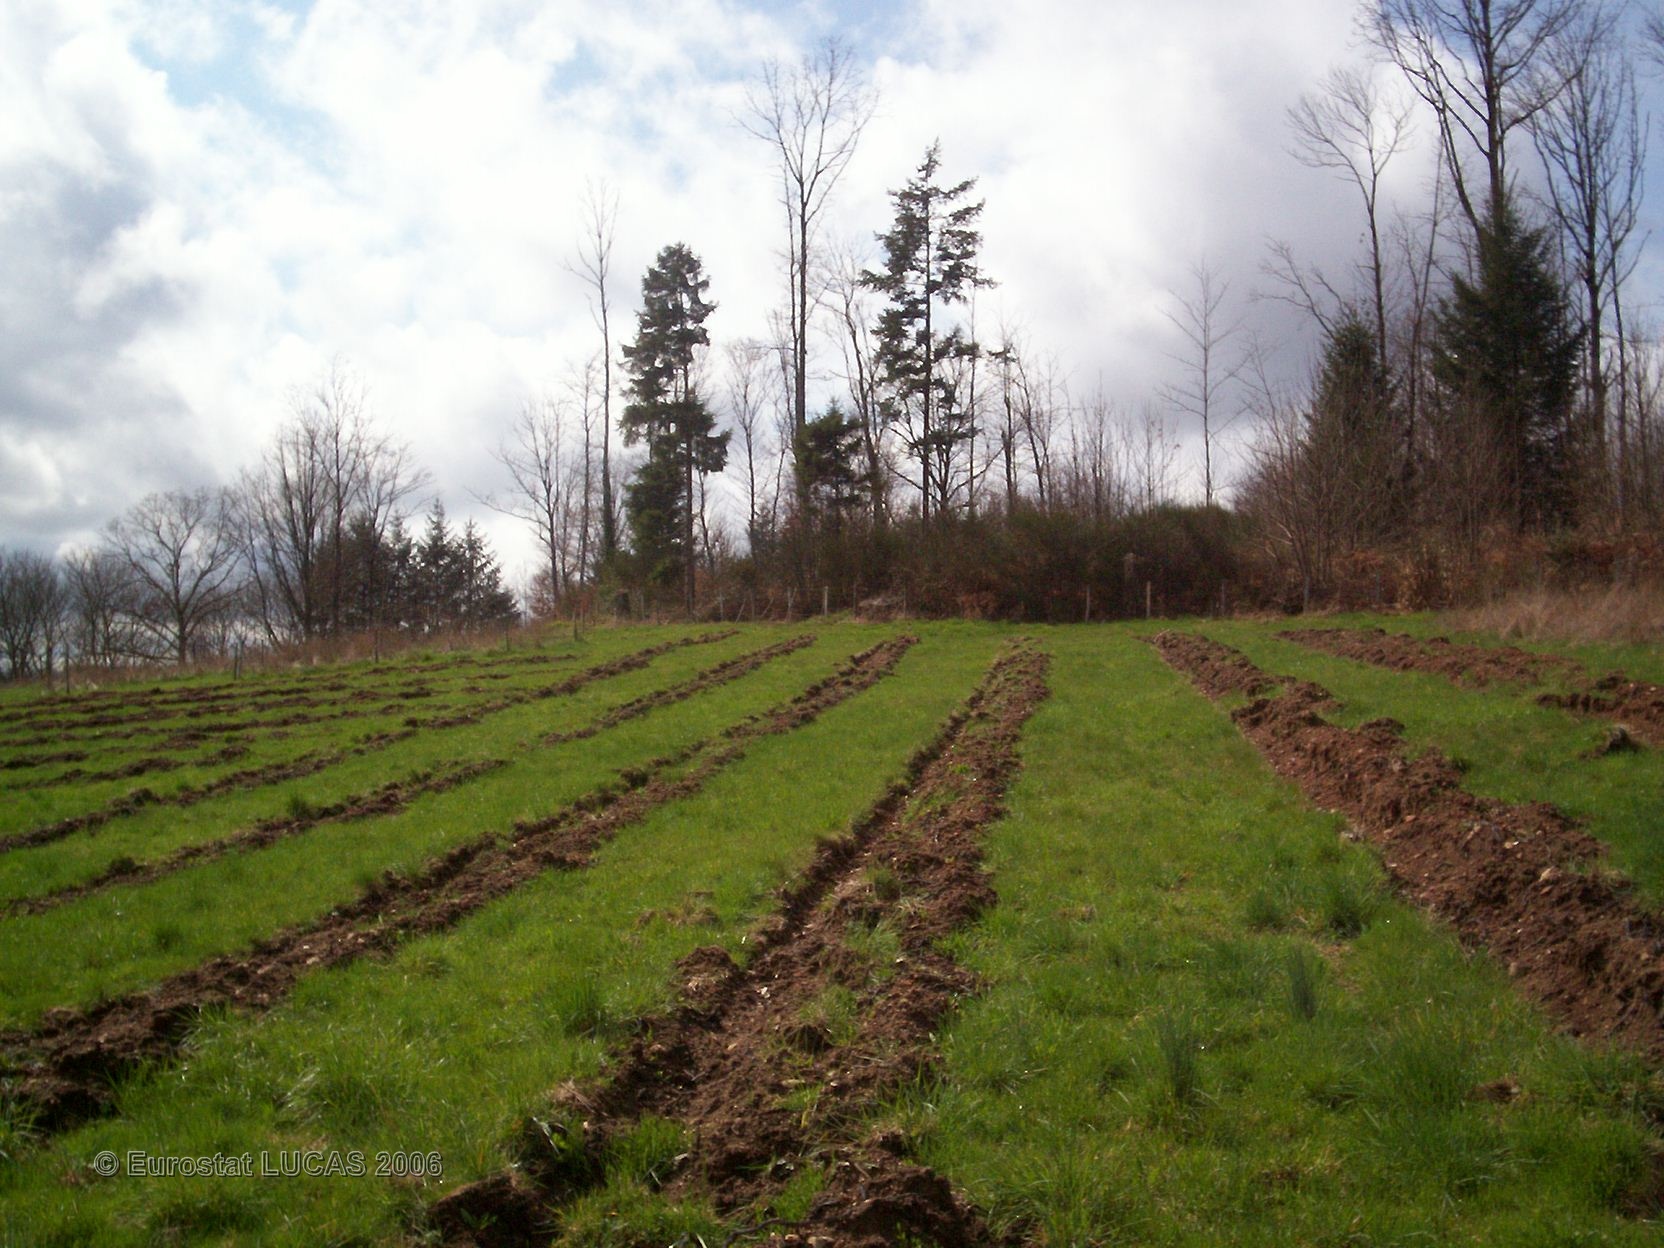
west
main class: Grassland
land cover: Grassland without tree/shrub cover
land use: Agriculture (excluding fallow land and kitchen gardens)
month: April
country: FR
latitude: 45.5479
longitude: 1.5787
